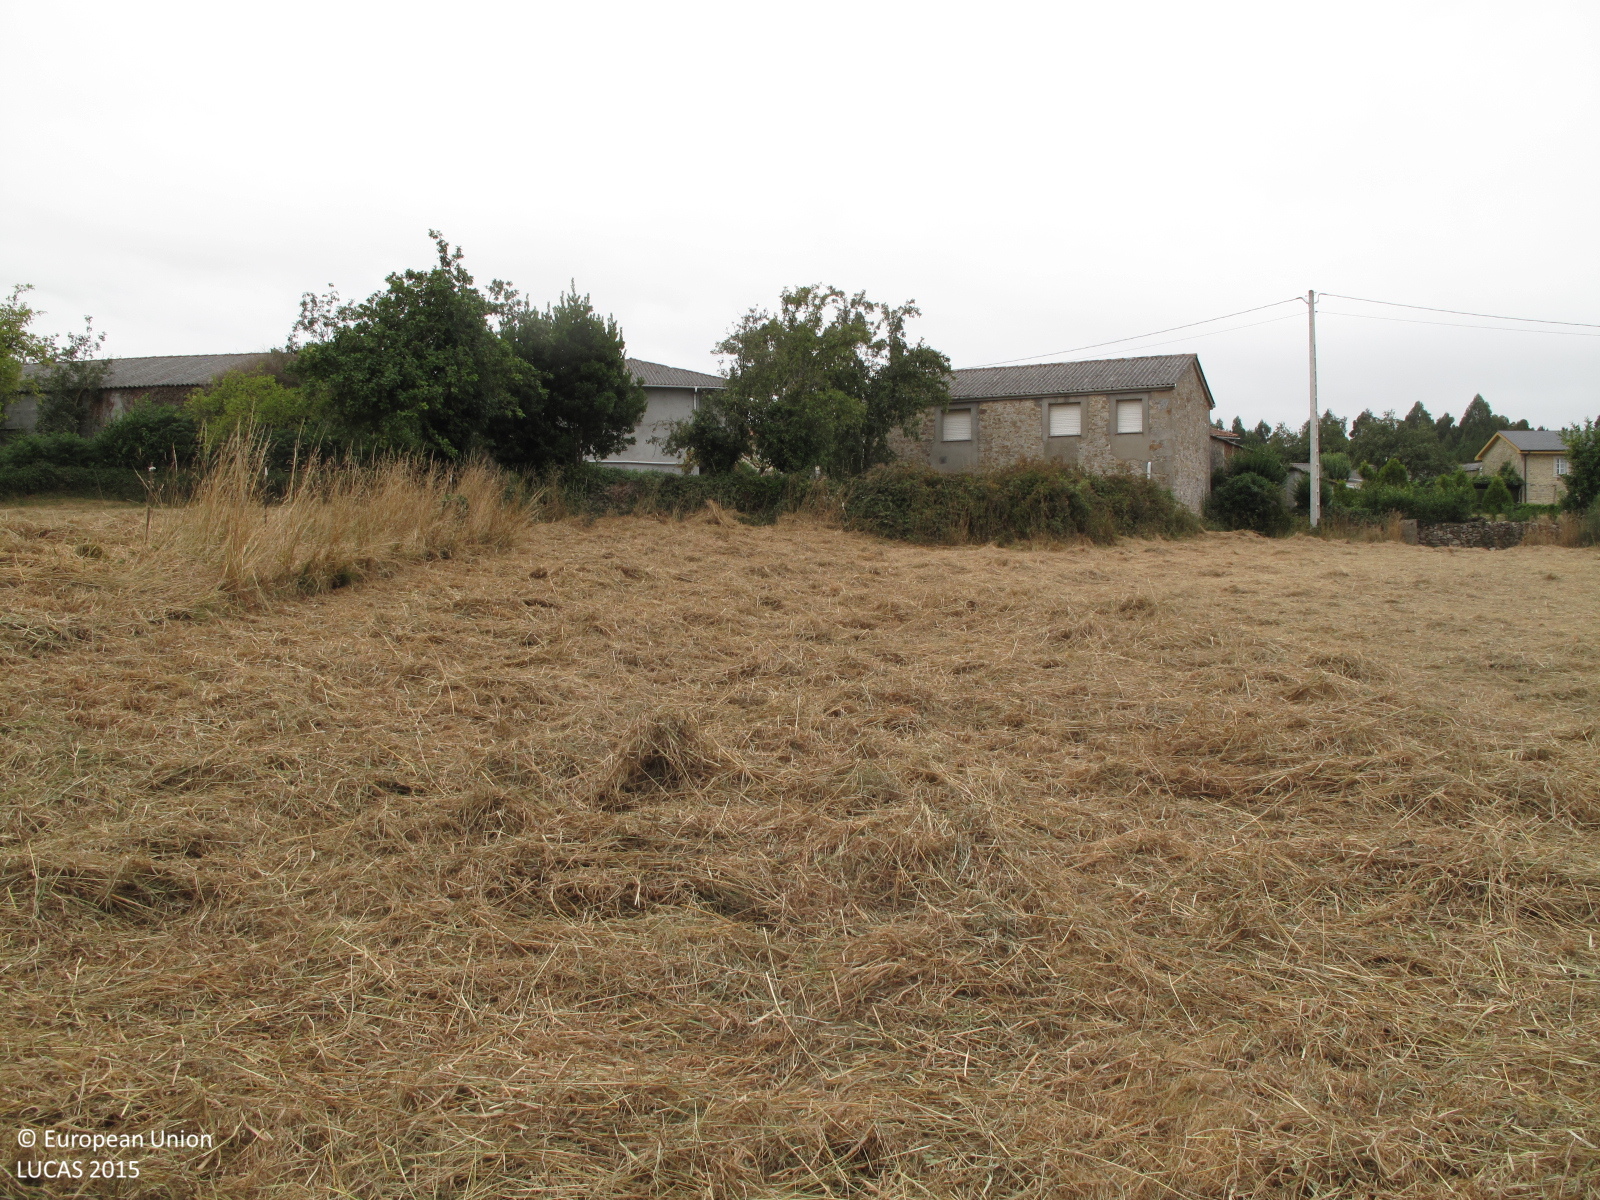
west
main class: Grassland
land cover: Grassland without tree/shrub cover
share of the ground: > 75 %
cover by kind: herbaceous plants 100 %
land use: Agriculture (excluding fallow land and kitchen gardens)
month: July
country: ES
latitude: 43.1815
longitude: -8.0182
